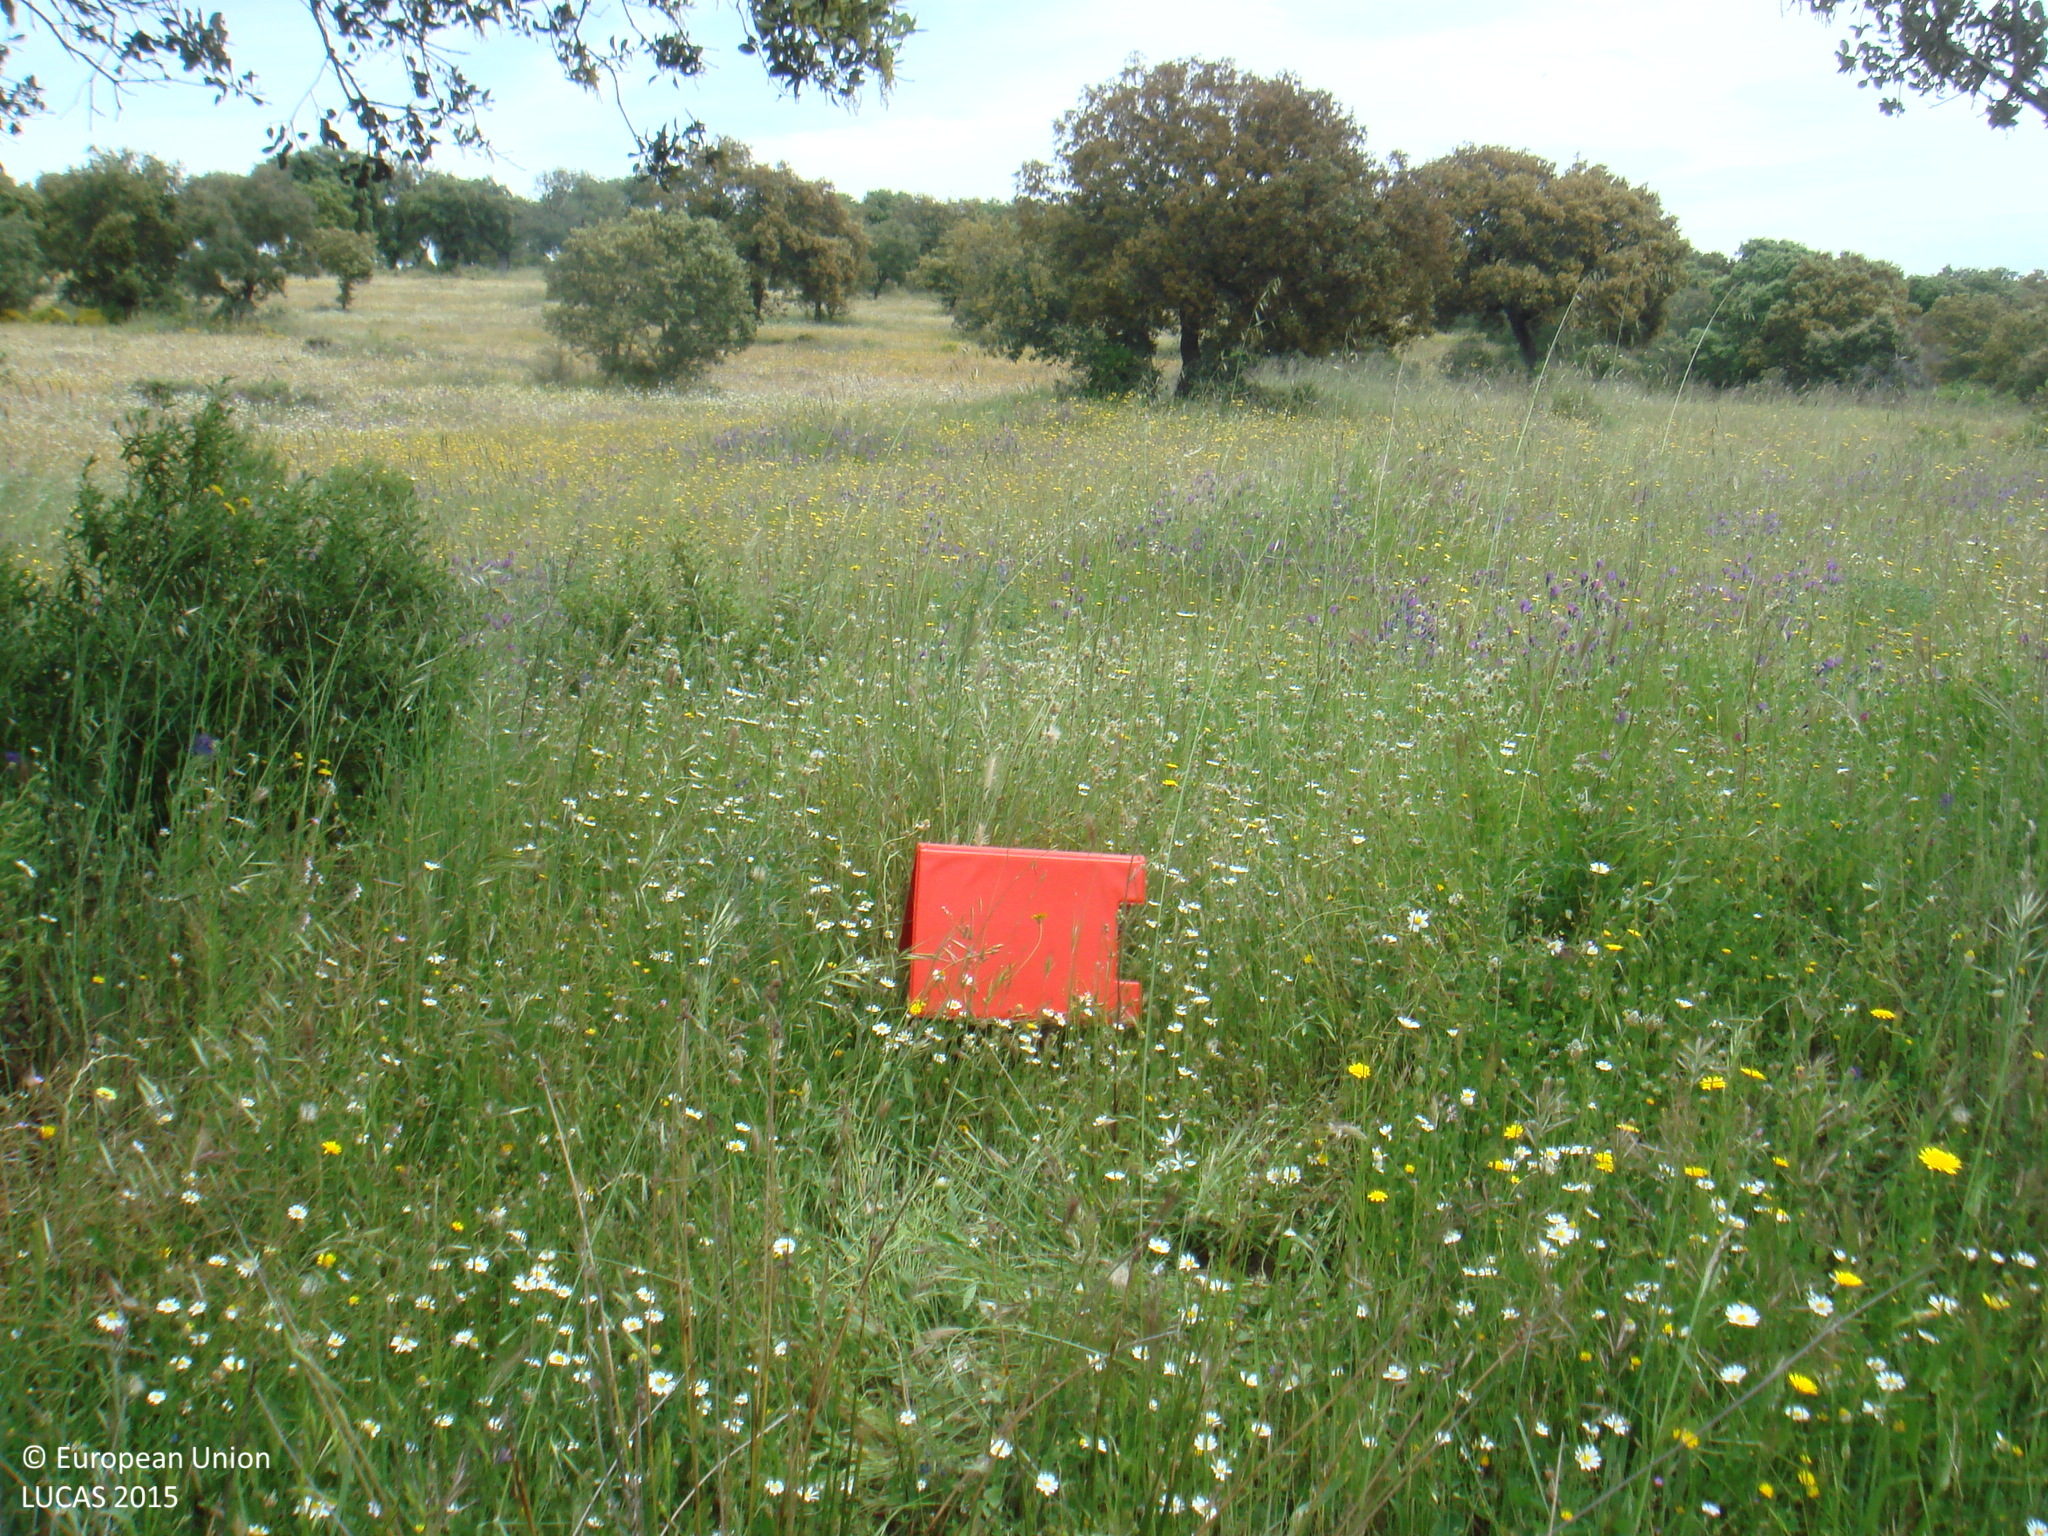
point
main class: Woodland
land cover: Broadleaved woodland
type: broadleaved evergreen forest
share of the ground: 10 - 25 %
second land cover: Grassland without tree/shrub cover
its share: > 75 %
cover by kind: herbaceous plants 80 %, broadleaved forest trees 15 %, shrubs 5 %
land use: Forestry
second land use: Agriculture (excluding fallow land and kitchen gardens)
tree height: > 5 m
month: May
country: ES
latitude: 38.3420
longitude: -5.0715
